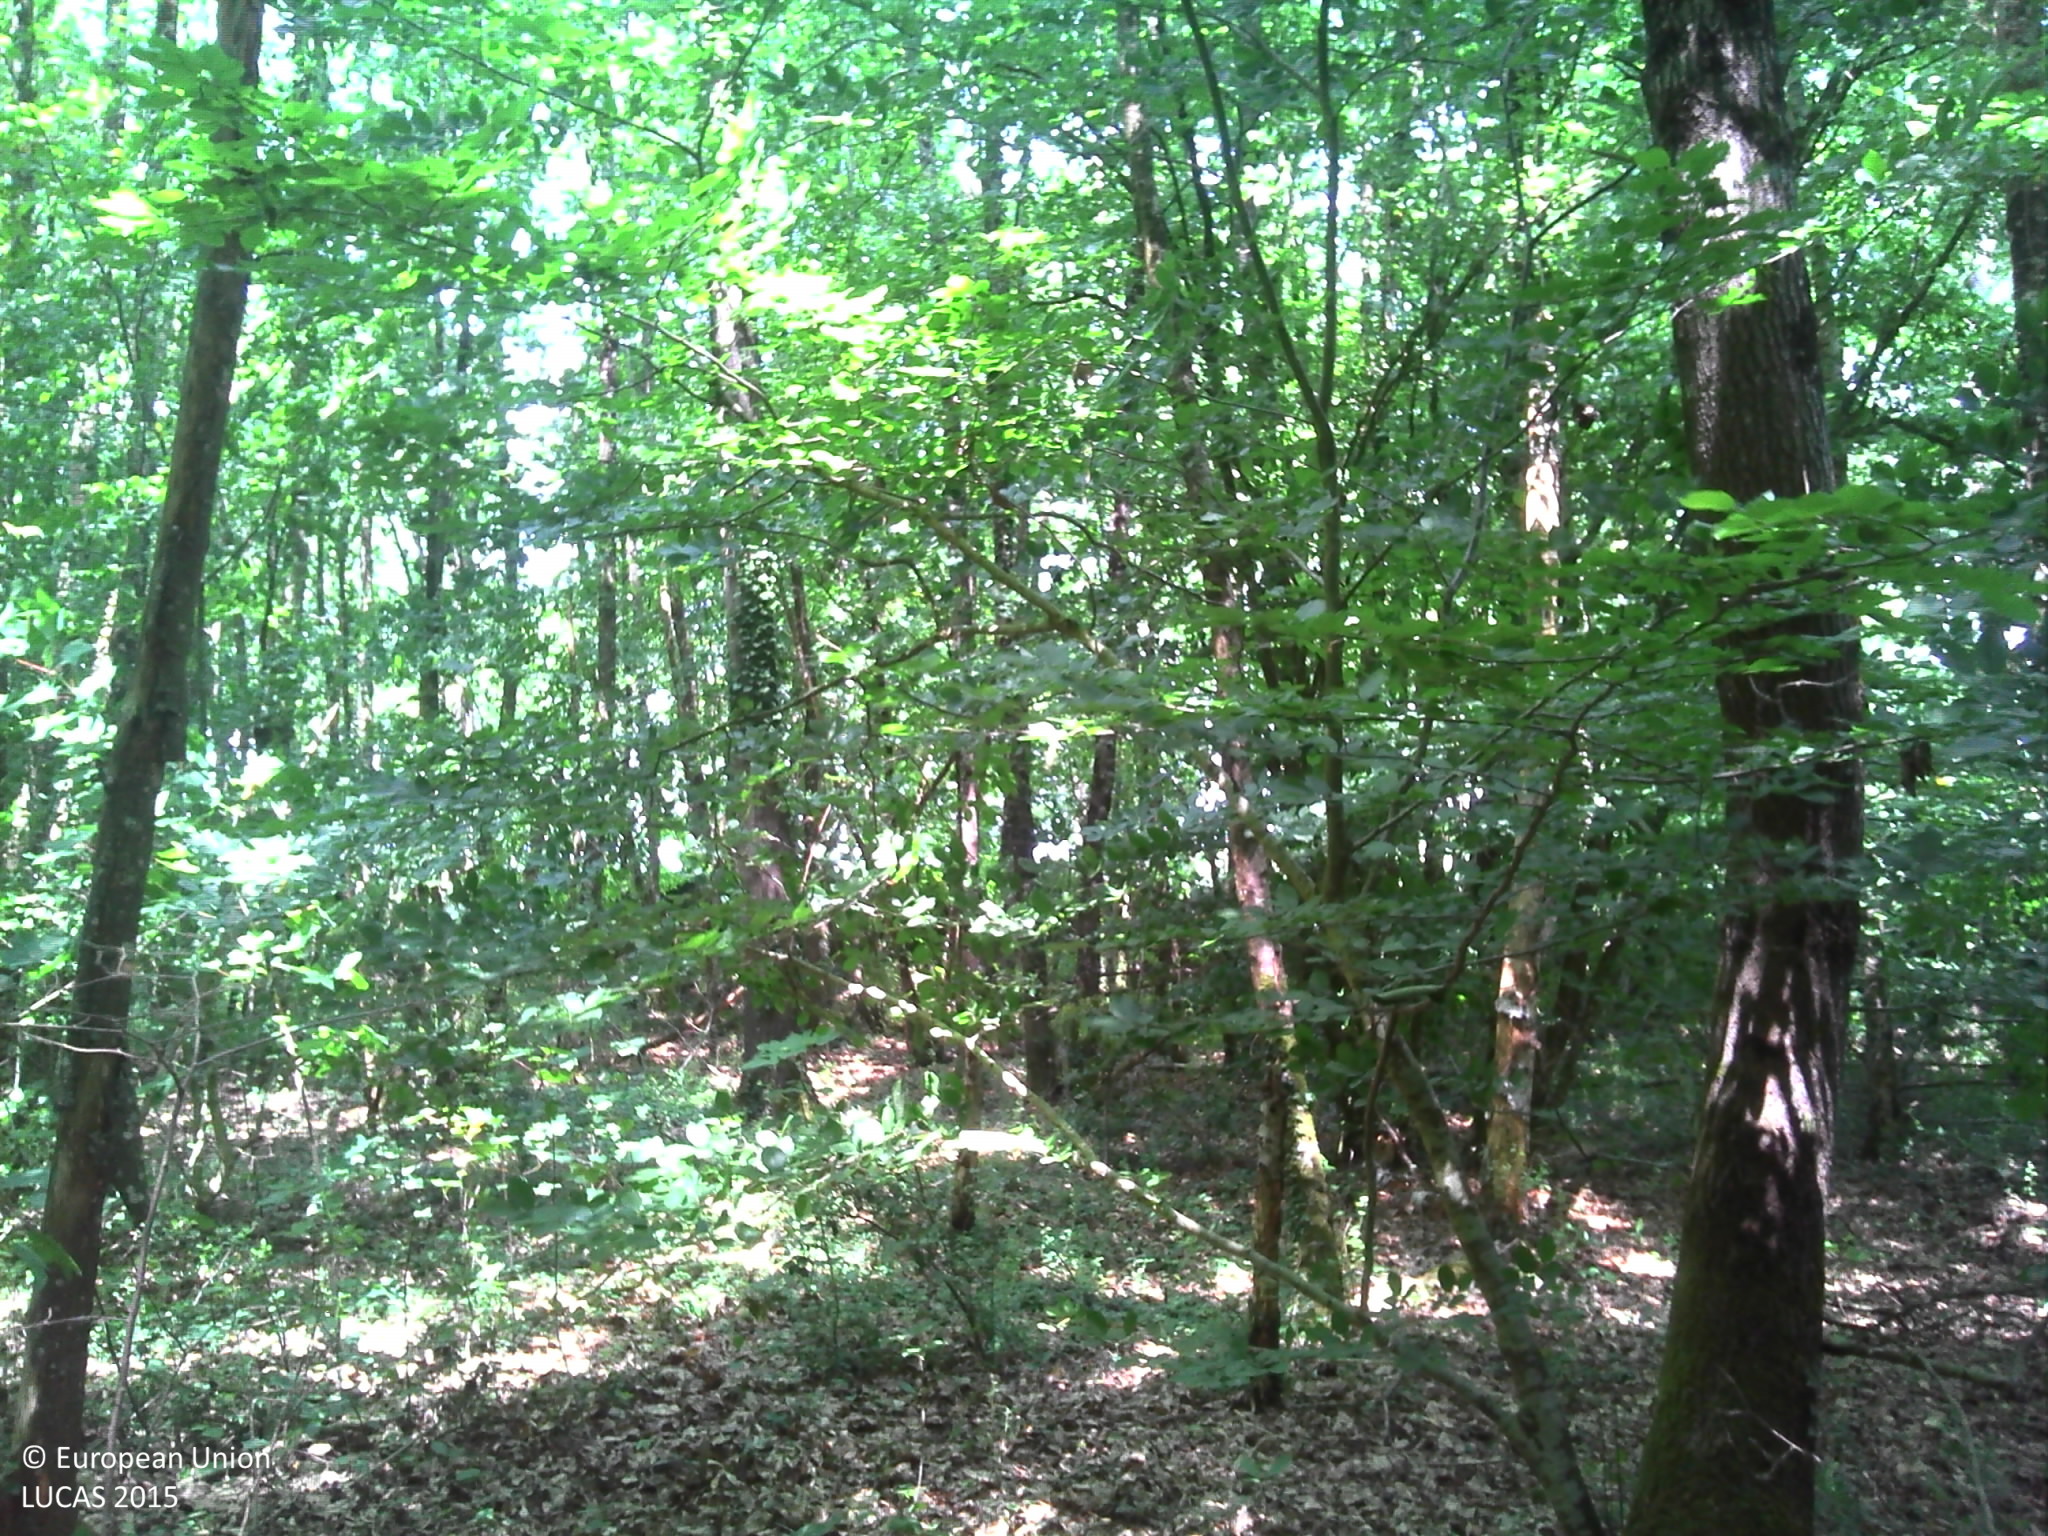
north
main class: Woodland
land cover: Broadleaved woodland
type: mesophytic deciduous forest
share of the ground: > 75 %
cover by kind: broadleaved forest trees 55 %, lichens and mosses 20 %, coniferous forest trees 15 %, herbaceous plants 10 %
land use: Forestry
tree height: > 5 m
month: June
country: FR
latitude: 47.7909
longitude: 0.0551
